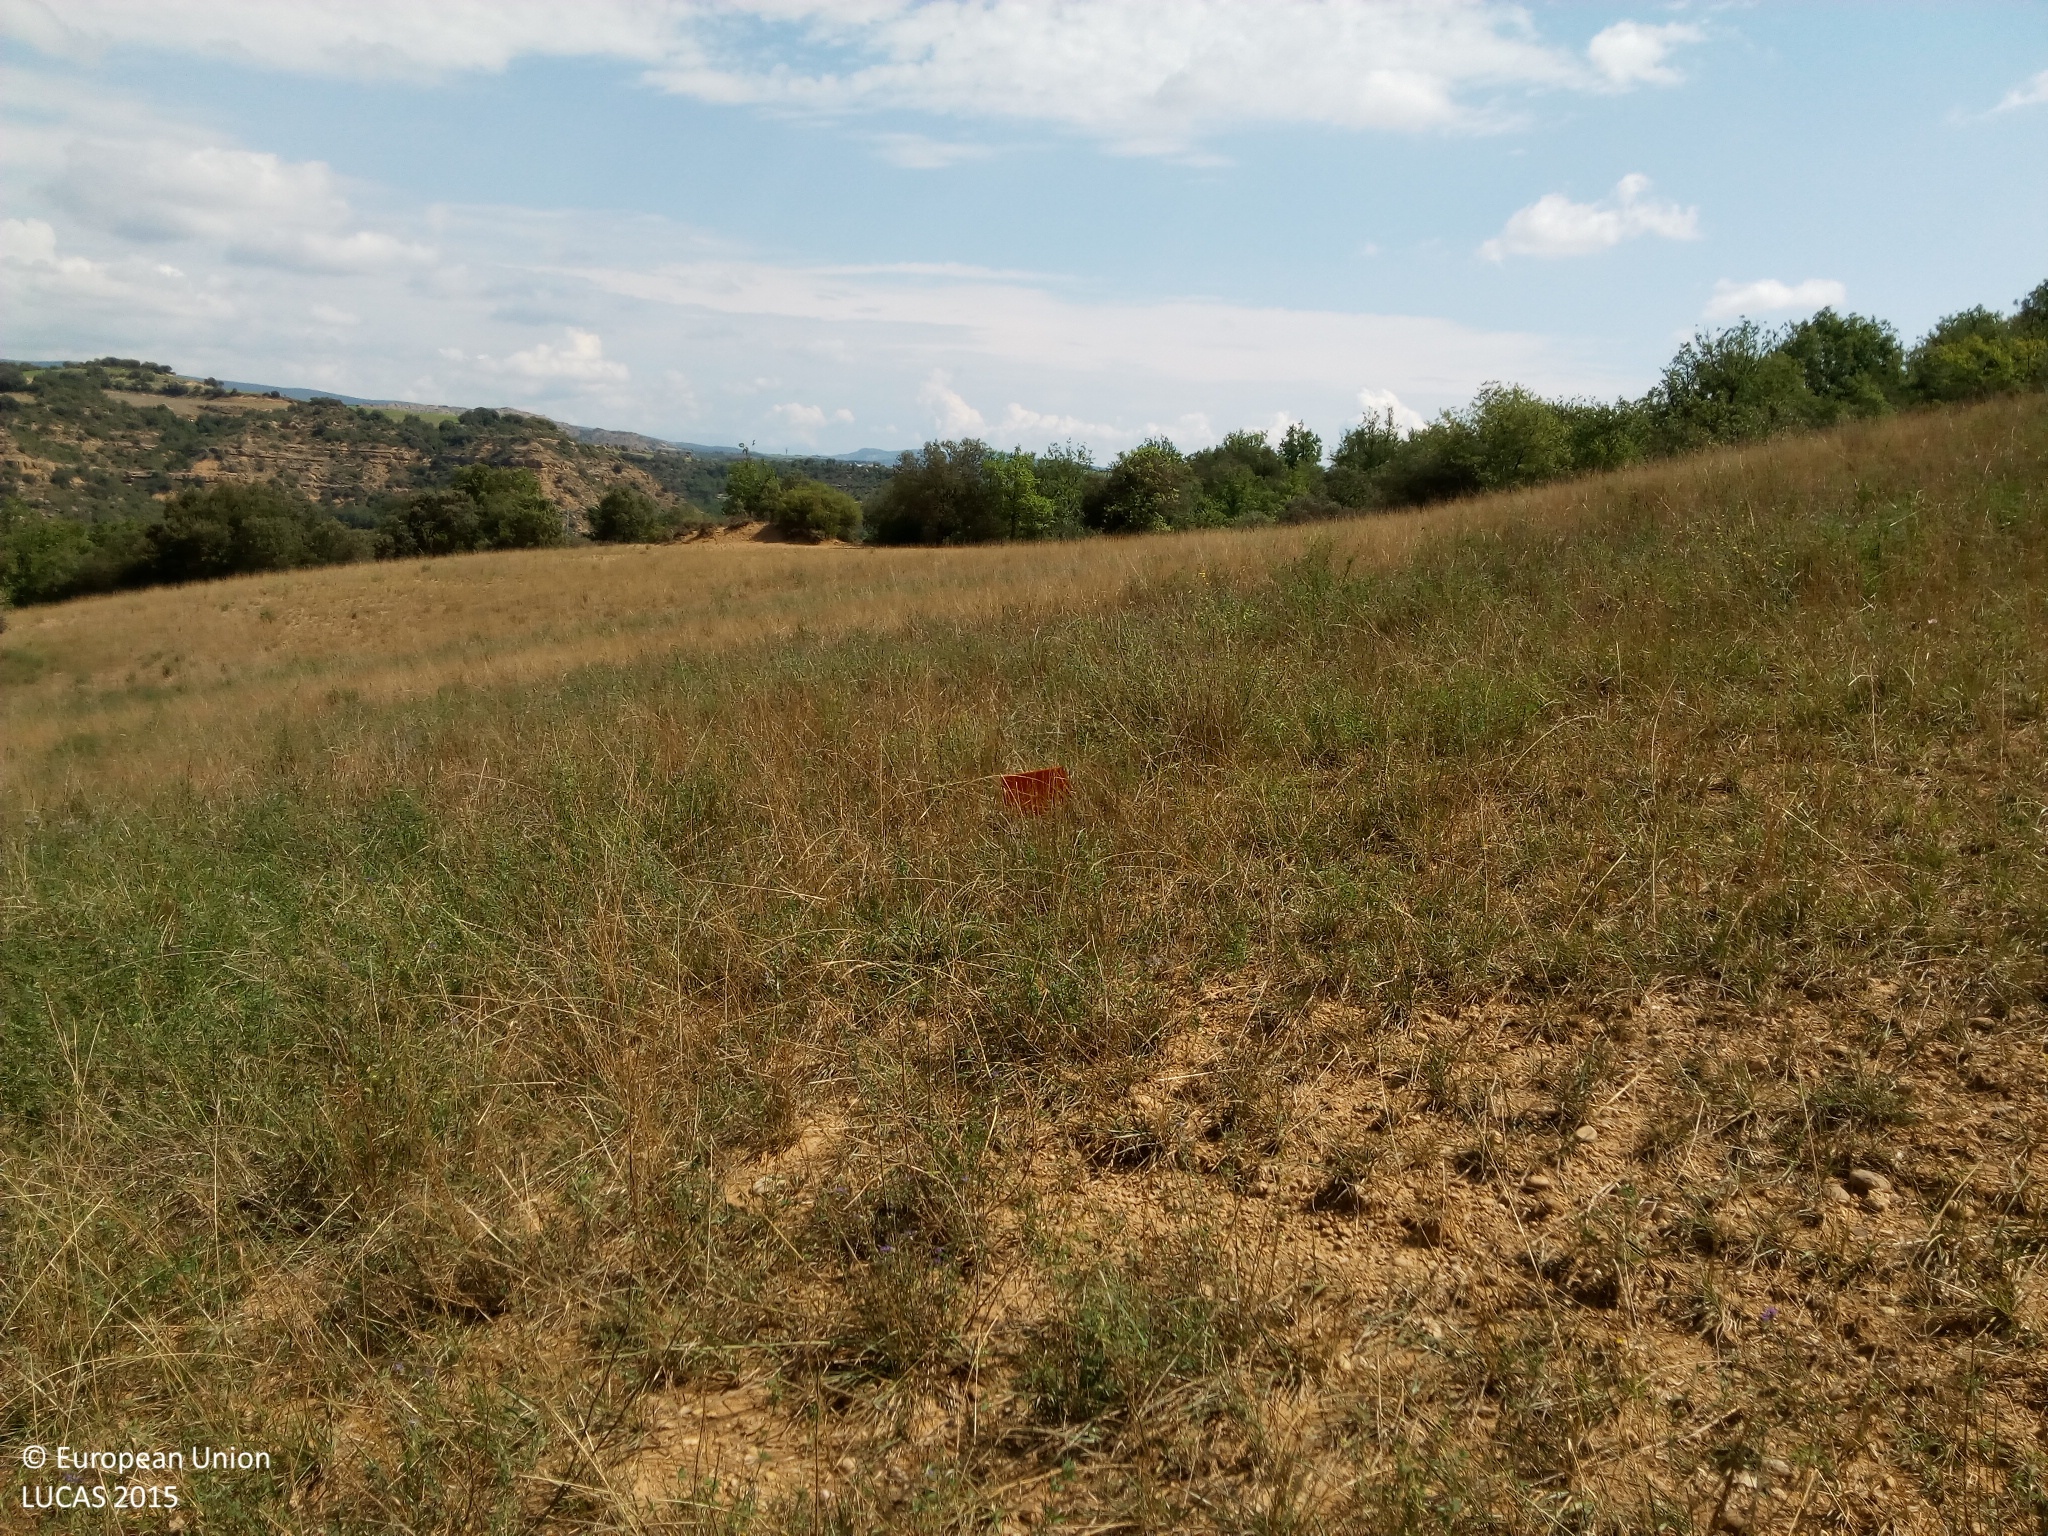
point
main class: Grassland
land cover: Grassland without tree/shrub cover
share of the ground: > 75 %
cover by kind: unconsolidated bare surface 60 %, herbaceous plants 40 %
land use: Agriculture (excluding fallow land and kitchen gardens)
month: August
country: ES
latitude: 42.0789
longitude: 0.4946
